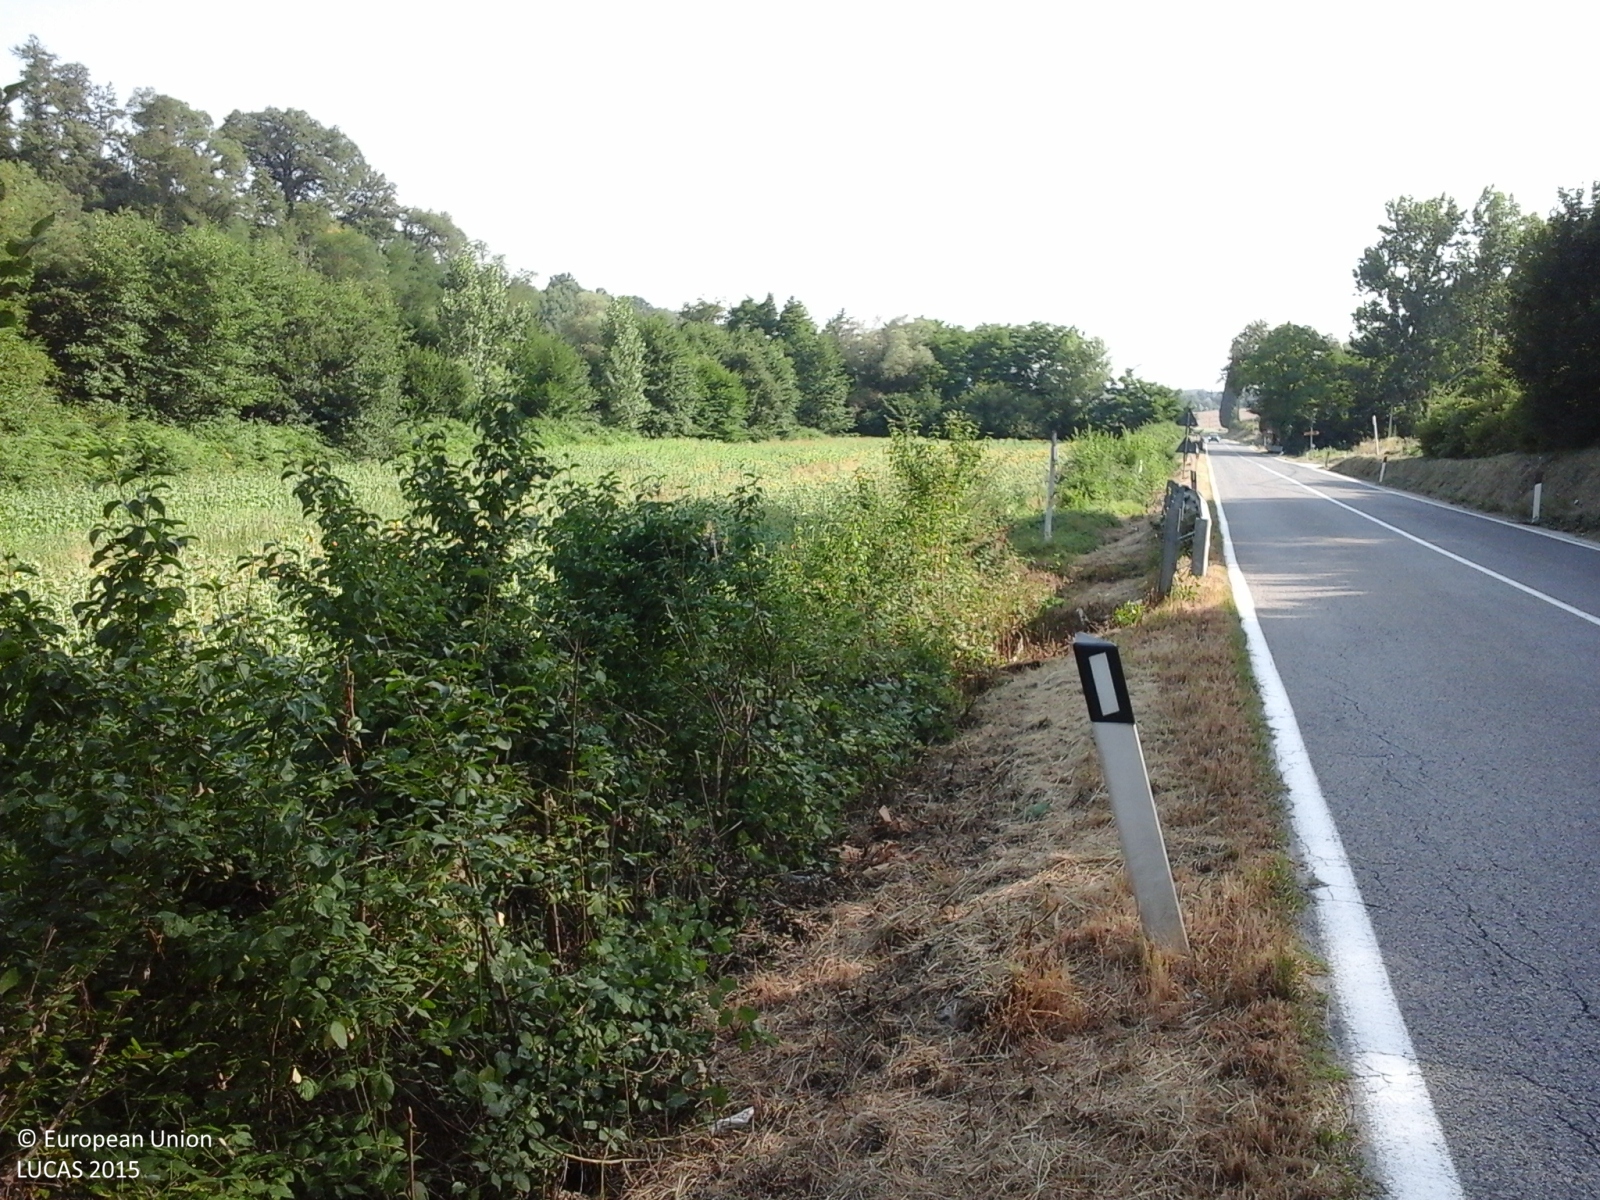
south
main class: Cropland
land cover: Sunflower
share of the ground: > 75 %
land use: Agriculture (excluding fallow land and kitchen gardens)
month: July
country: IT
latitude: 43.3463
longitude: 11.5623
